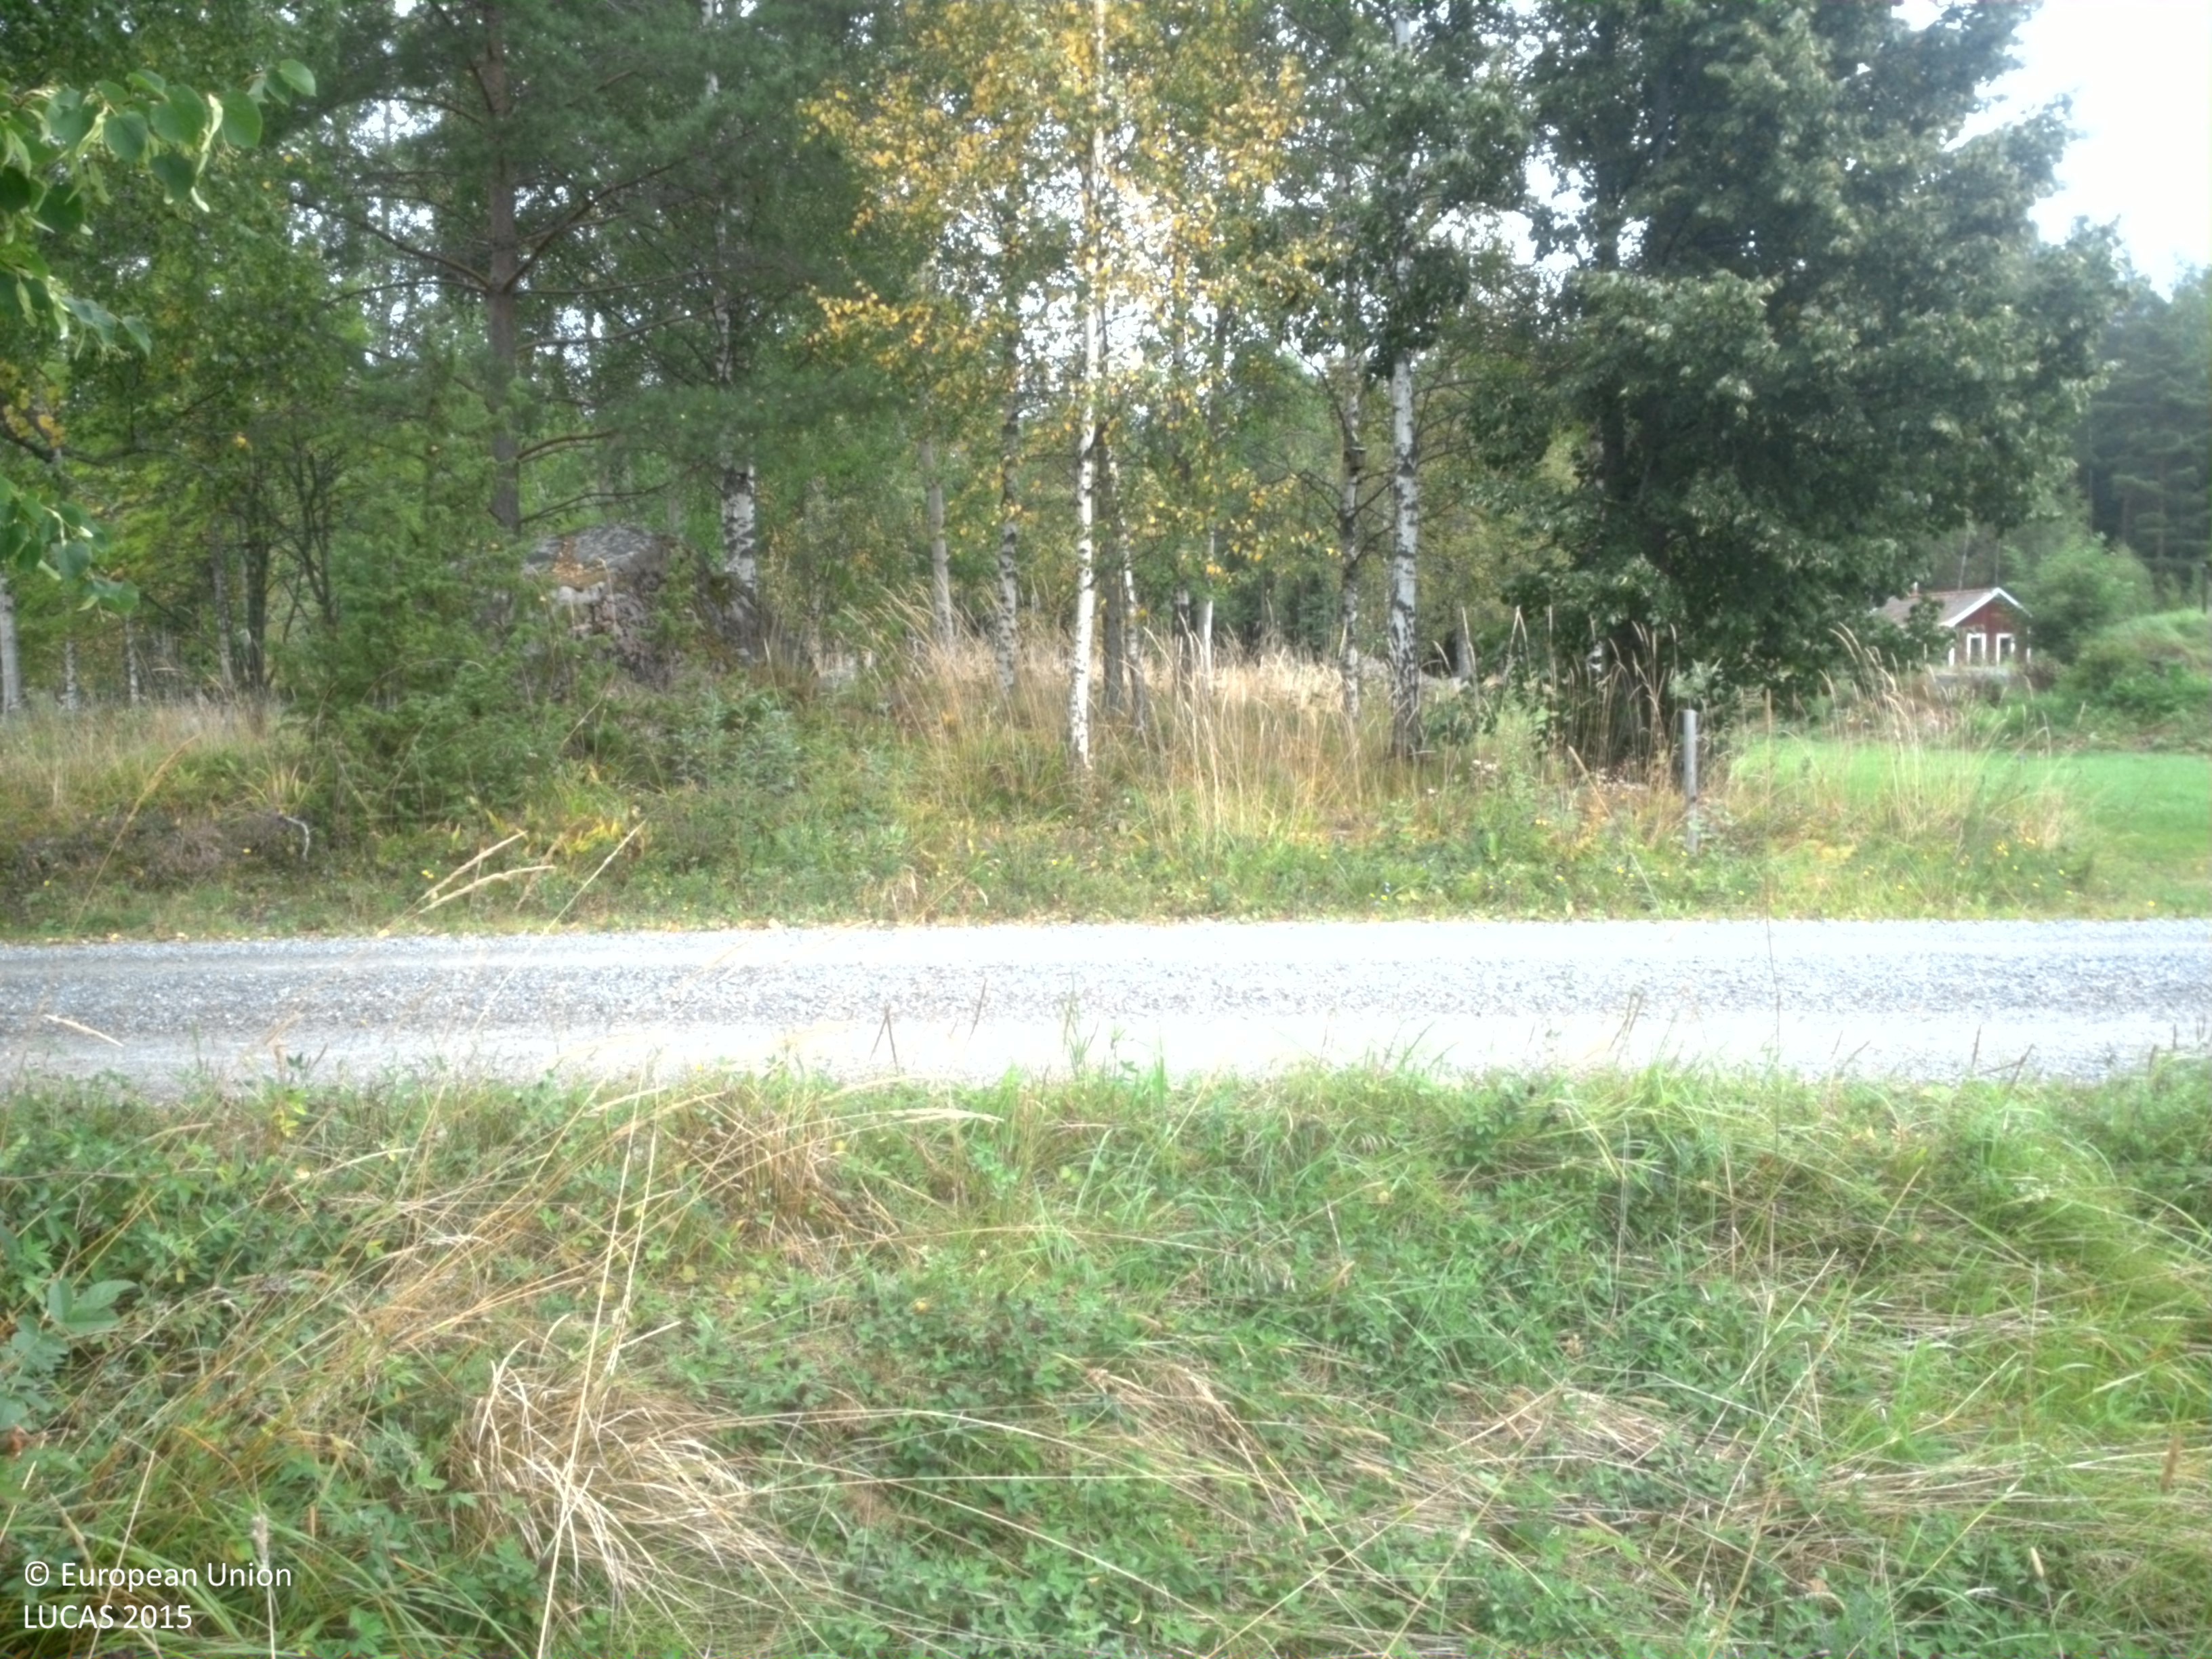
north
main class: Cropland
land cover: Oats
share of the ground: > 75 %
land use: Agriculture (excluding fallow land and kitchen gardens)
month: August
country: SE
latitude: 59.6824
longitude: 15.7983
